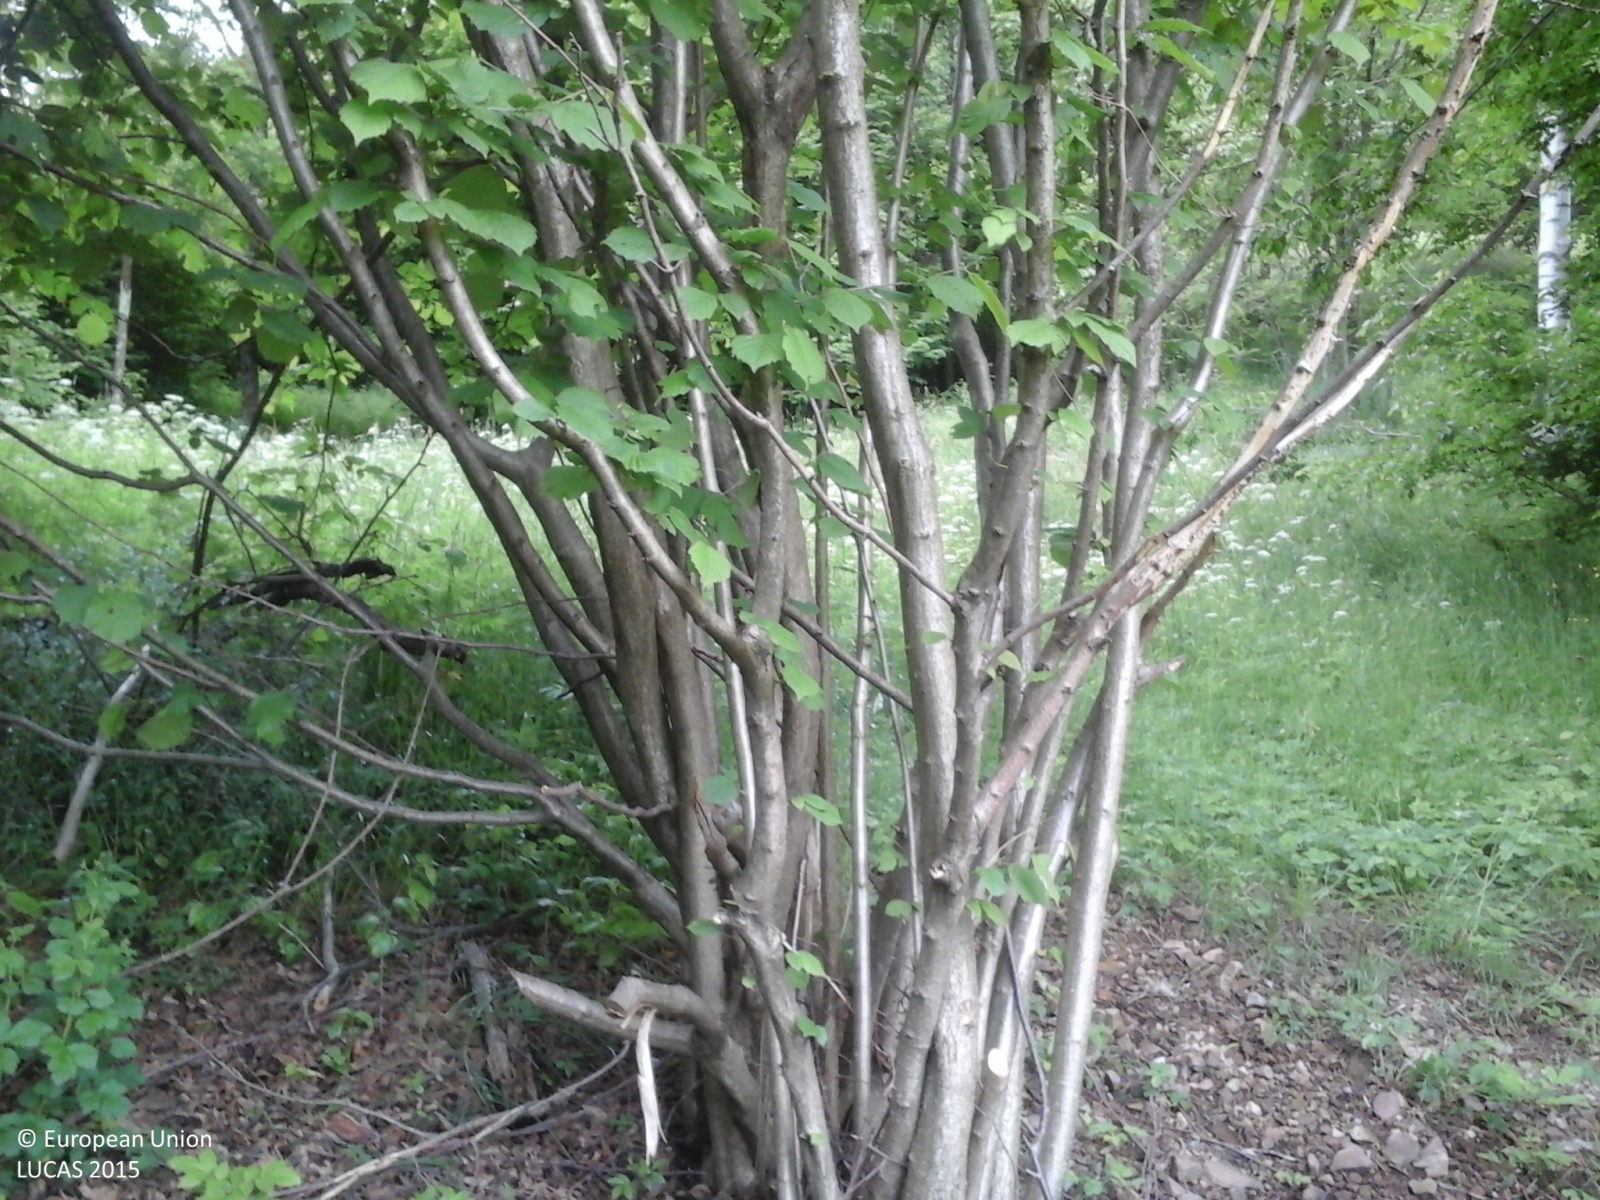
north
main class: Woodland
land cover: Broadleaved woodland
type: thermophilous deciduous forest
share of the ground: > 75 %
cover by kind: broadleaved forest trees 90 %, herbaceous plants 10 %
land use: Forestry
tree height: > 5 m
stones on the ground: < 10 %
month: May
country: IT
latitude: 45.7854
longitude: 11.2458
